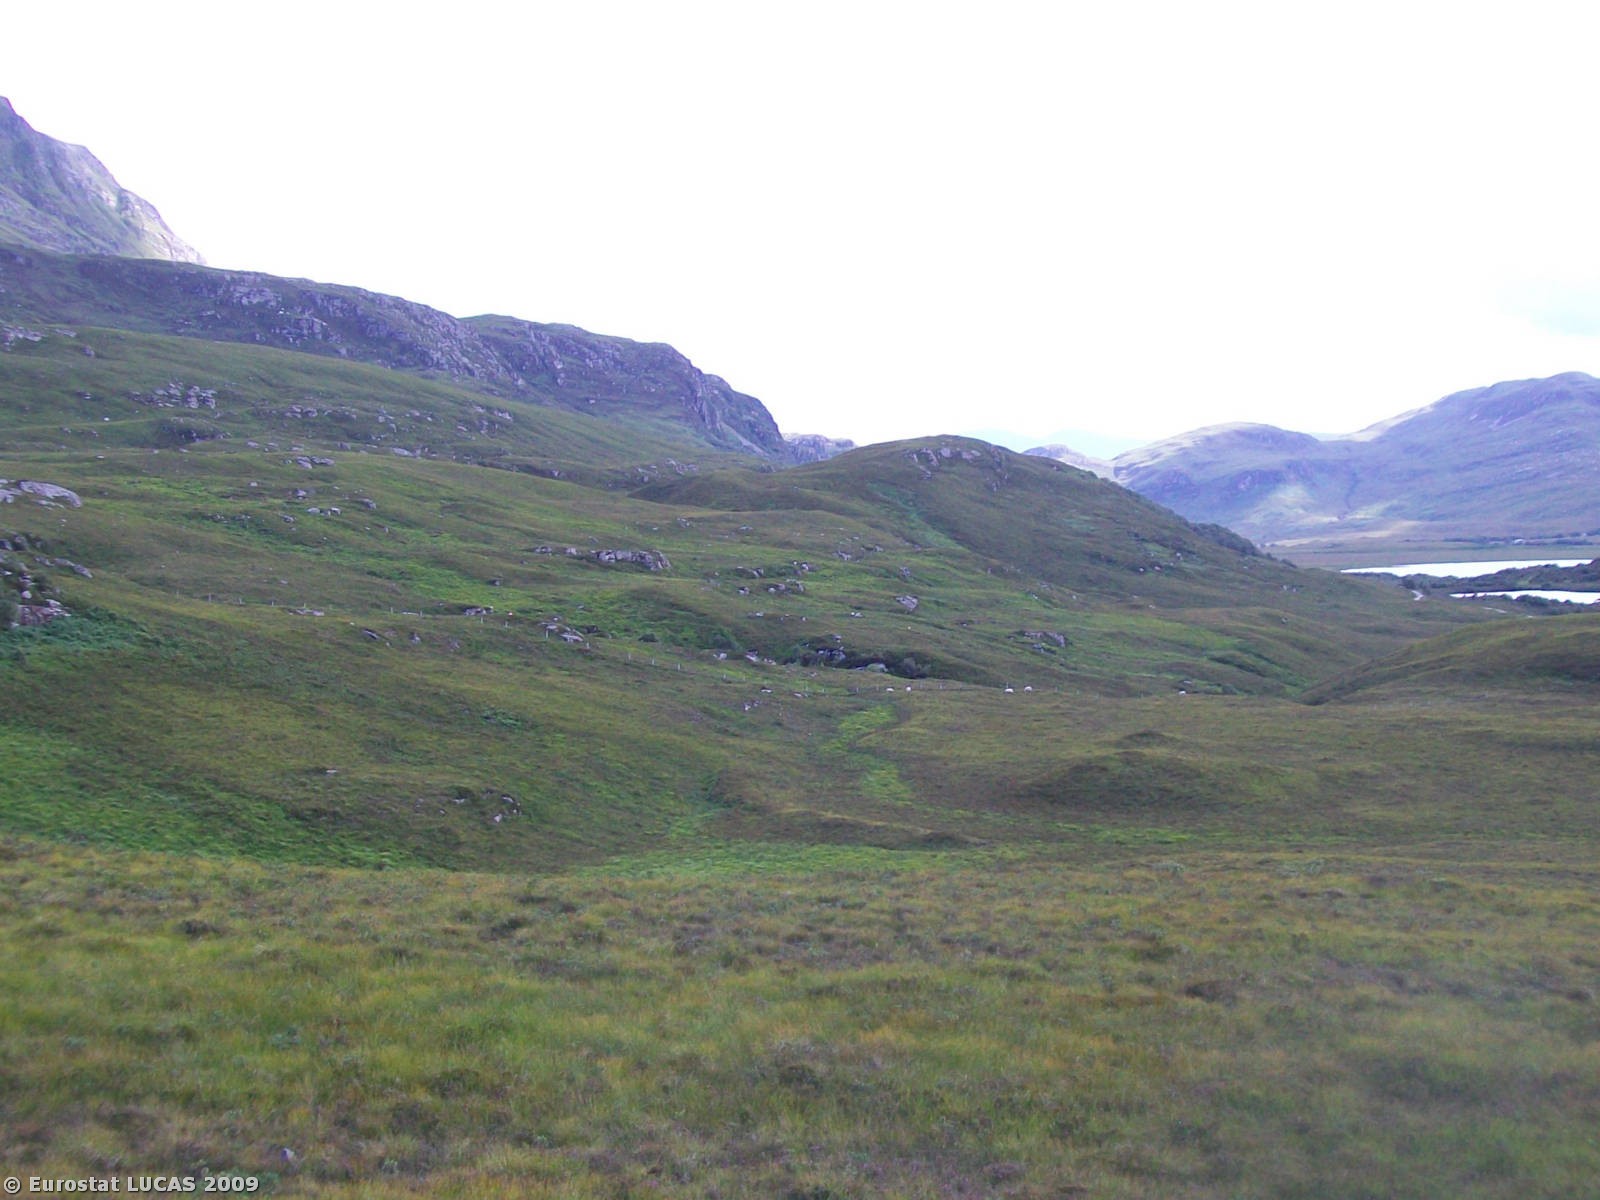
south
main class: Shrubland
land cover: Shrubland without tree cover
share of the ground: > 75 %
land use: Agriculture (excluding fallow land and kitchen gardens)
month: July
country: GB
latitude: 58.4392
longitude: -4.6314
